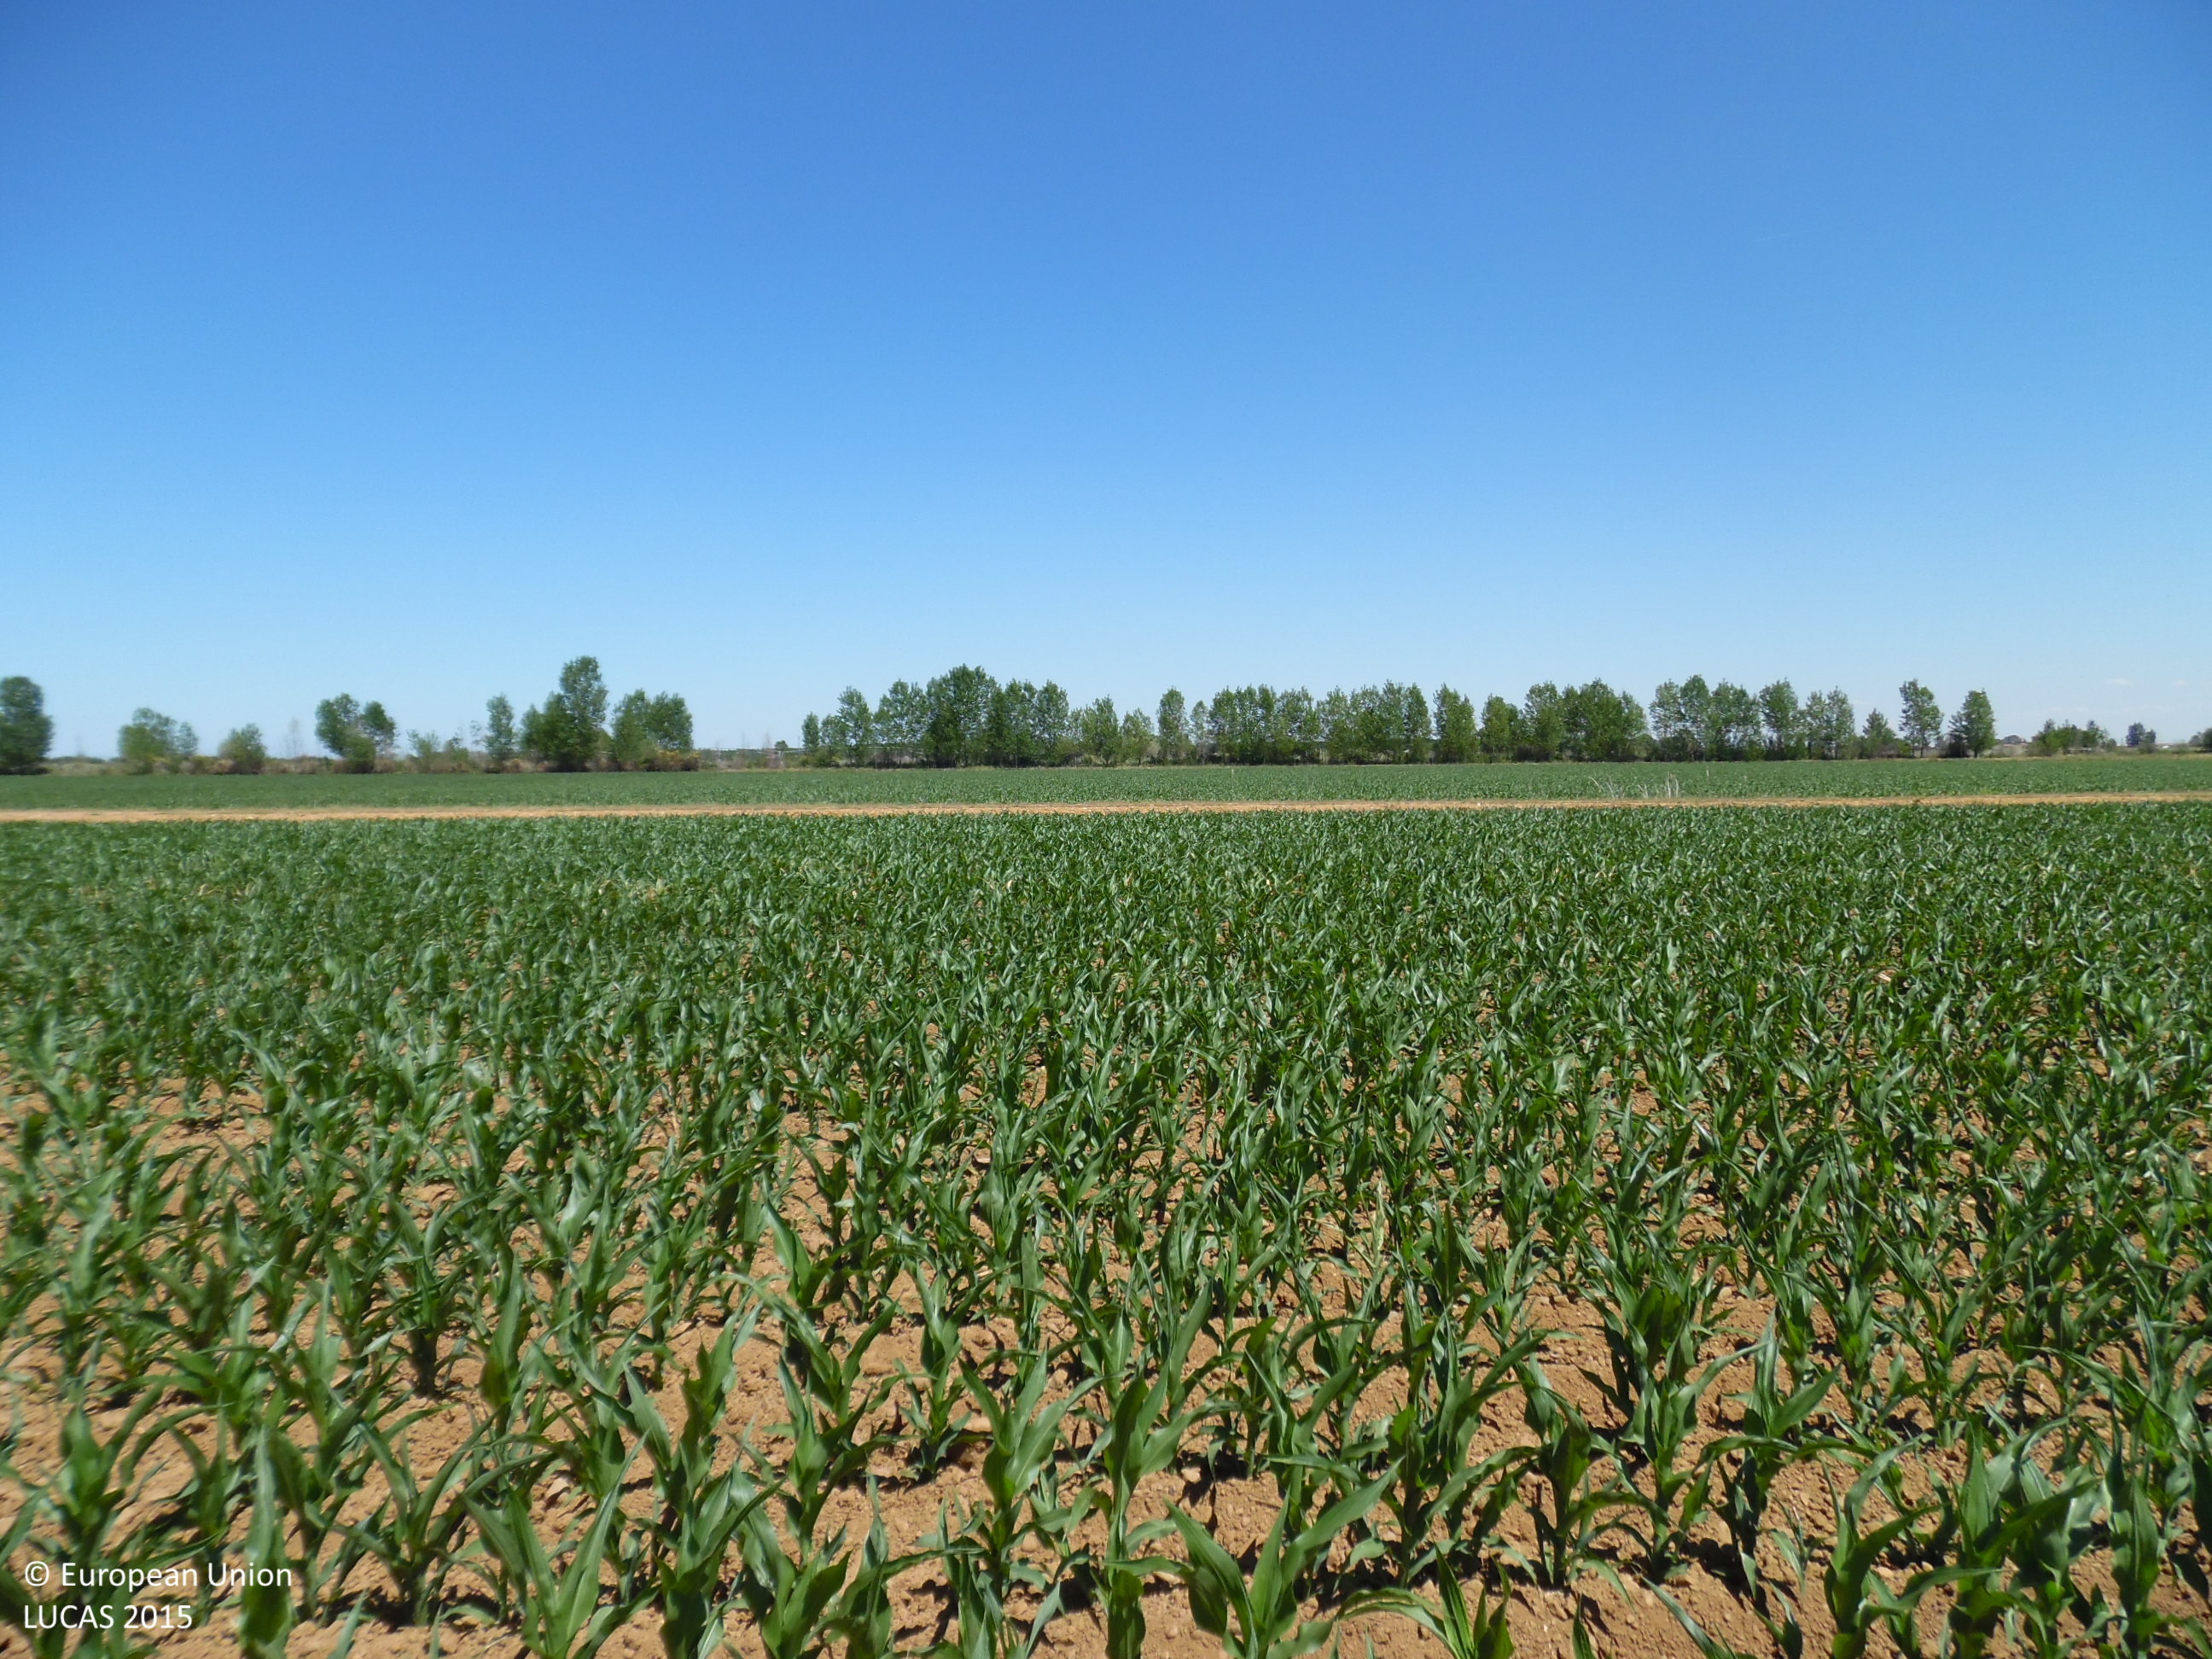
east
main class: Cropland
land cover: Maize
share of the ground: 25 - 50 %
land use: Agriculture (excluding fallow land and kitchen gardens)
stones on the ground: 10 - 25 %
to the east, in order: Maize; Grass margins; Tracks; Grass margins; Maize; Grass margins; Ditches and canals; Grass margins; Managed hedges; Grassland with sparse tree/shrub cover; Ditches and canals; Grass margins; Tracks; Grassland with sparse tree/shrub cover; Managed hedges; Maize
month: June
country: ES
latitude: 42.3890
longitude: -5.7312
